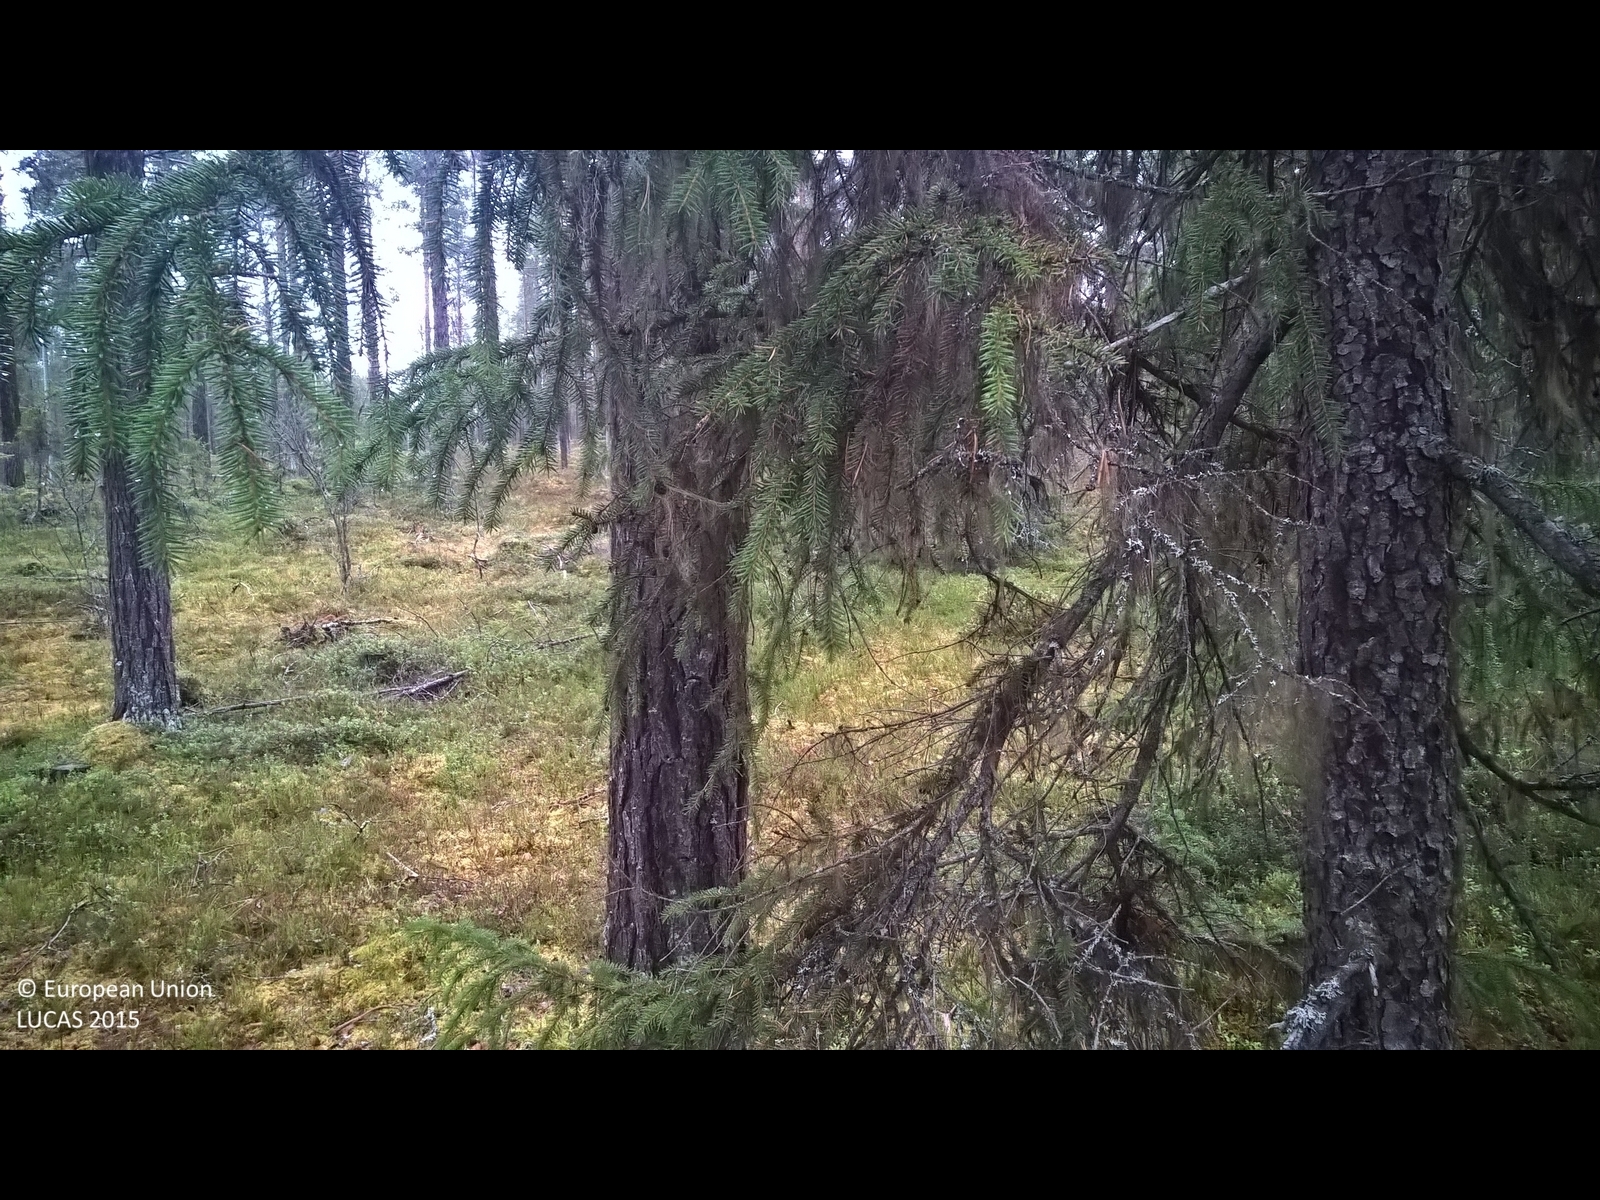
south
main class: Woodland
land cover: Pine dominated coniferous woodland
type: boreal forest
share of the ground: > 75 %
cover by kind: coniferous forest trees 75 %, lichens and mosses 20 %, broadleaved forest trees 5 %
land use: Forestry
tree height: > 5 m
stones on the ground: < 10 %
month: November
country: SE
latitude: 62.8169
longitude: 13.8087
